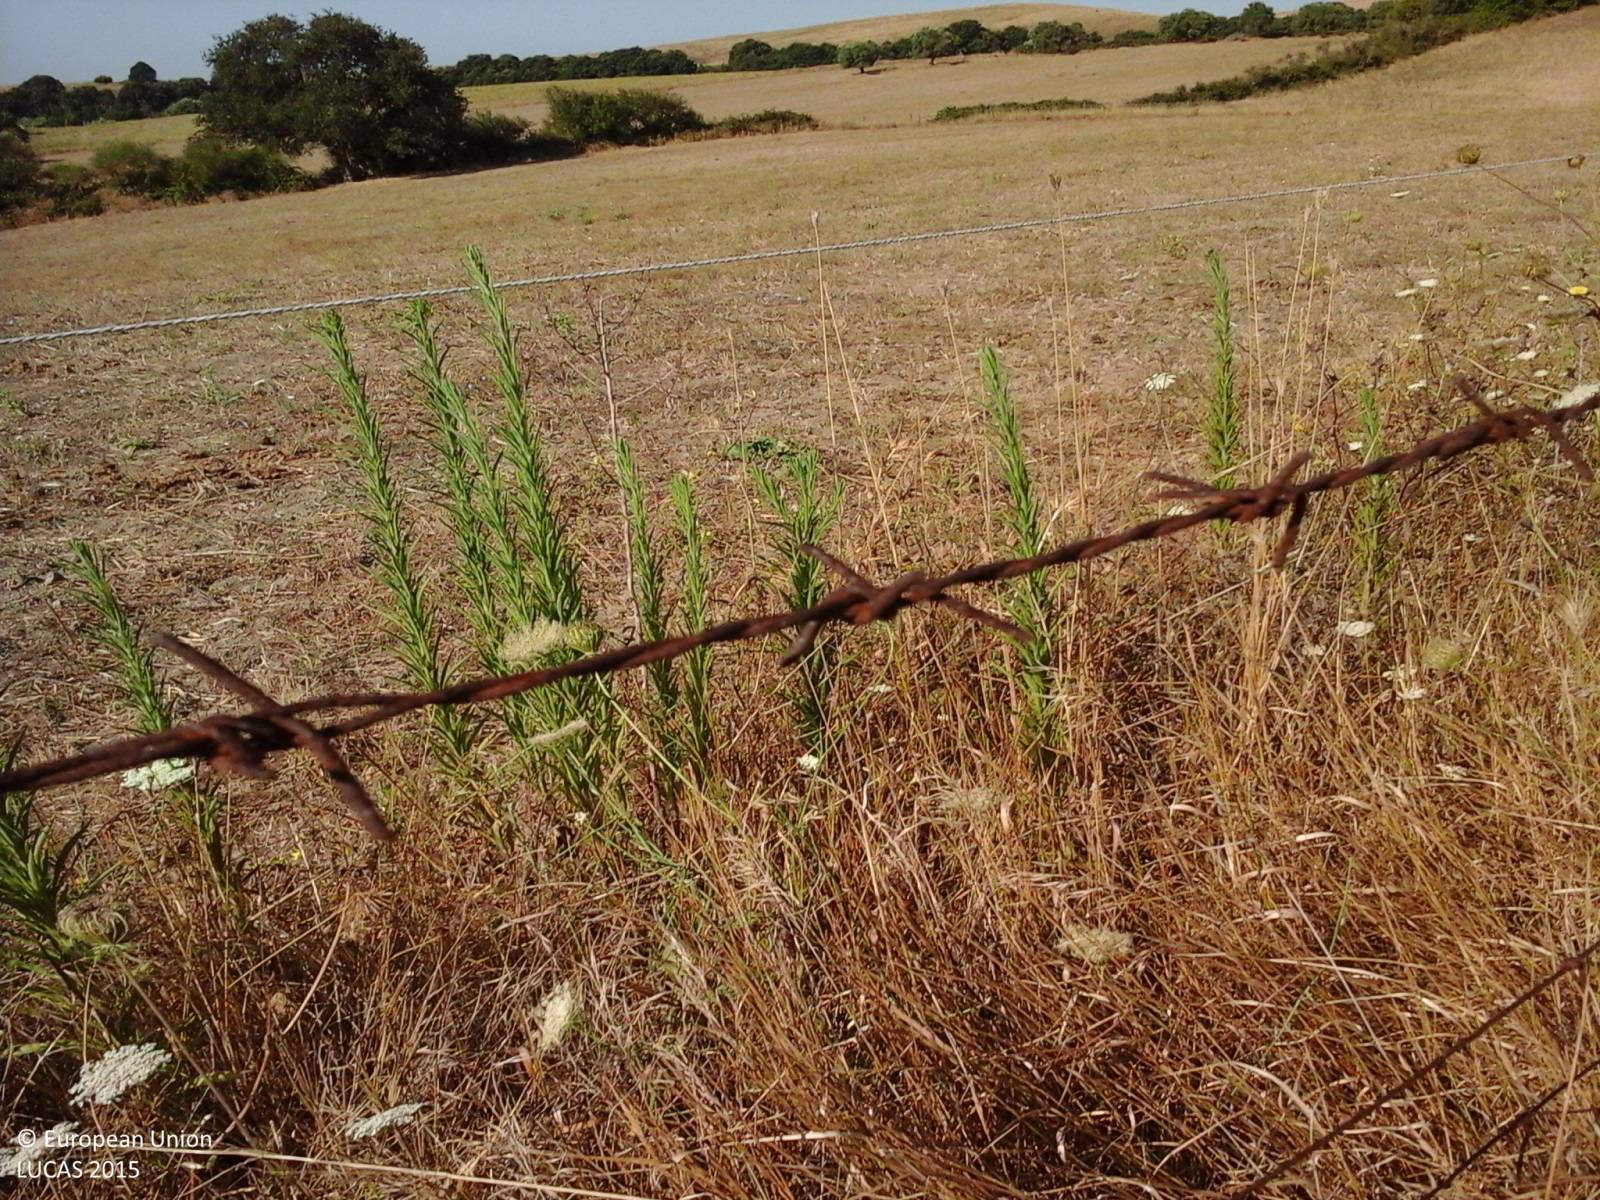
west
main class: Grassland
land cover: Grassland without tree/shrub cover
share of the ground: > 75 %
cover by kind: herbaceous plants 100 %
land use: Agriculture (excluding fallow land and kitchen gardens)
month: August
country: IT
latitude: 42.1027
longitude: 12.3495
